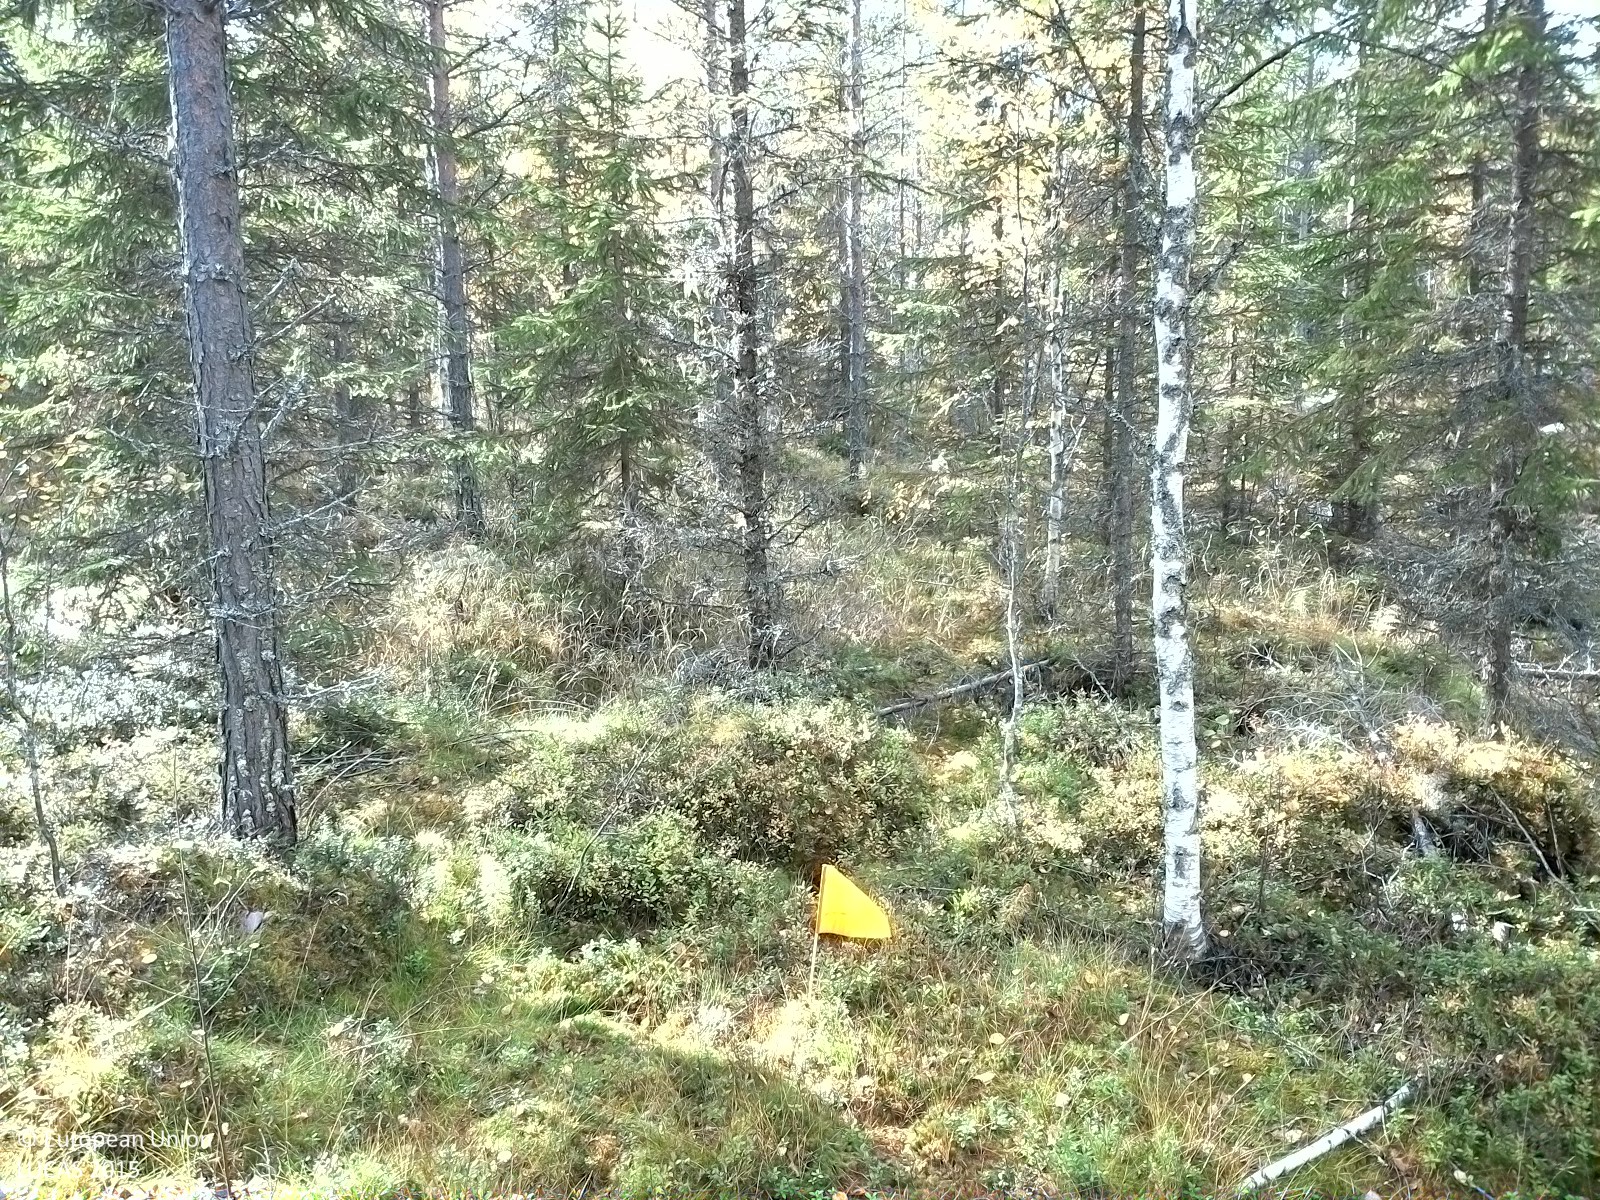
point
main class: Woodland
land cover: Spruce dominated mixed woodland
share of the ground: 50 - 75 %
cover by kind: broadleaved forest trees 35 %, lichens and mosses 30 %, shrubs 20 %, coniferous forest trees 15 %
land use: Forestry
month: September
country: SE
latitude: 62.1025
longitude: 15.3268
